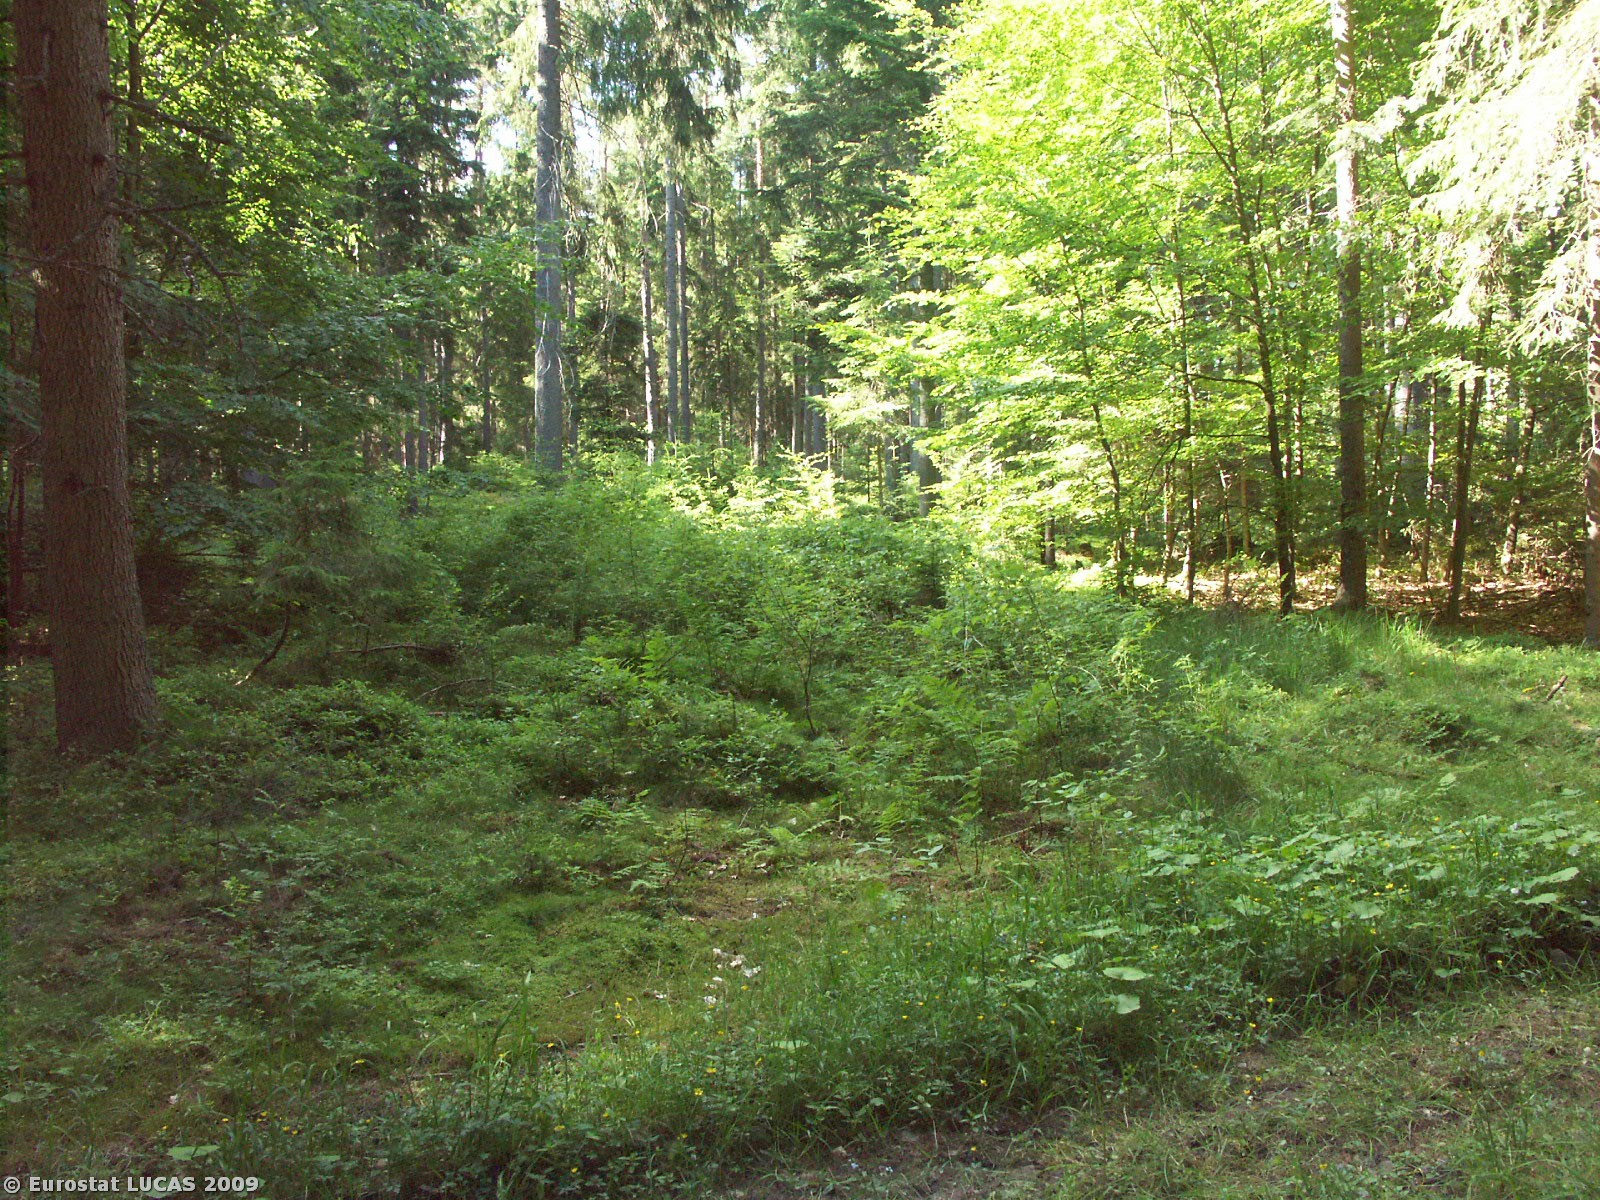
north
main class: Woodland
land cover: Coniferous woodland
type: hemiboreal forest and nemoral coniferous forest and mixed broadleaved-coniferous forest
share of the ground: > 75 %
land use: Forestry
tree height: > 5 m
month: June
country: CZ
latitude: 48.7221
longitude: 14.1463
